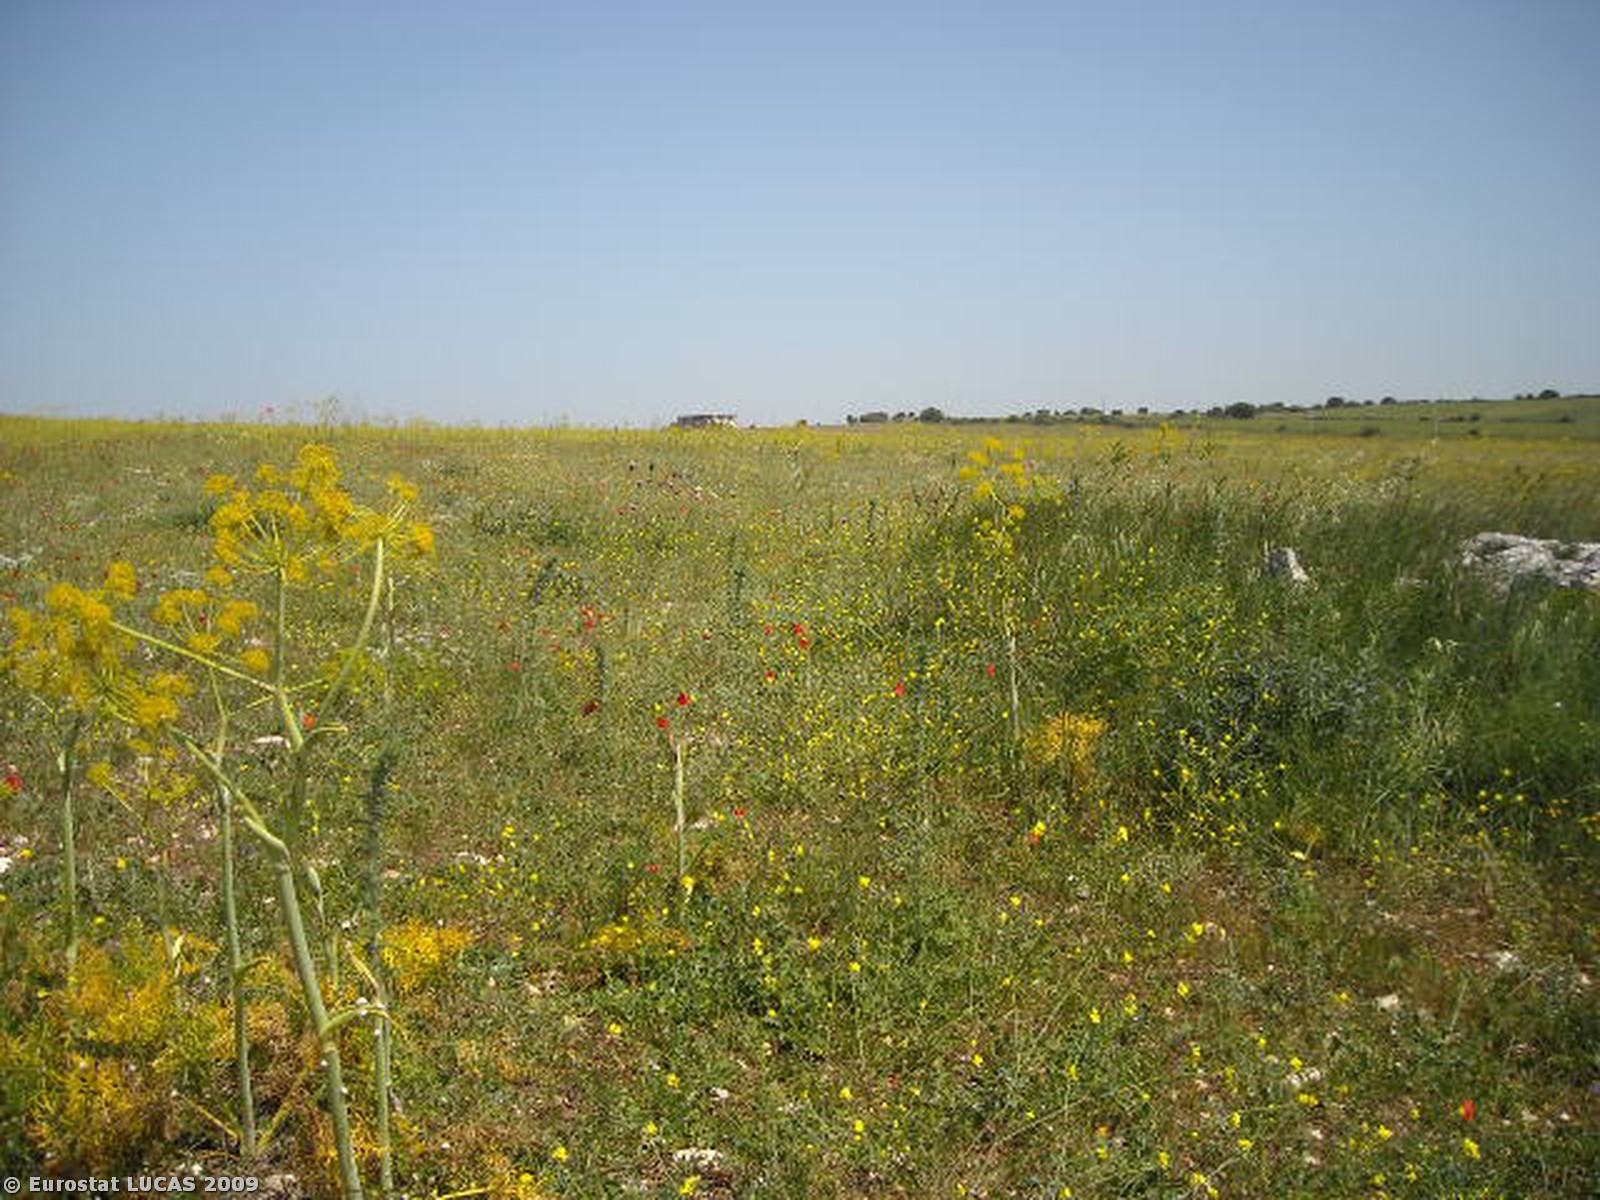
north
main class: Grassland
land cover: Spontaneously vegetated surfaces
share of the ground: > 75 %
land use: Fallow land
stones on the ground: 25 - 50 %
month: May
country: IT
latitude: 40.8954
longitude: 16.6371
